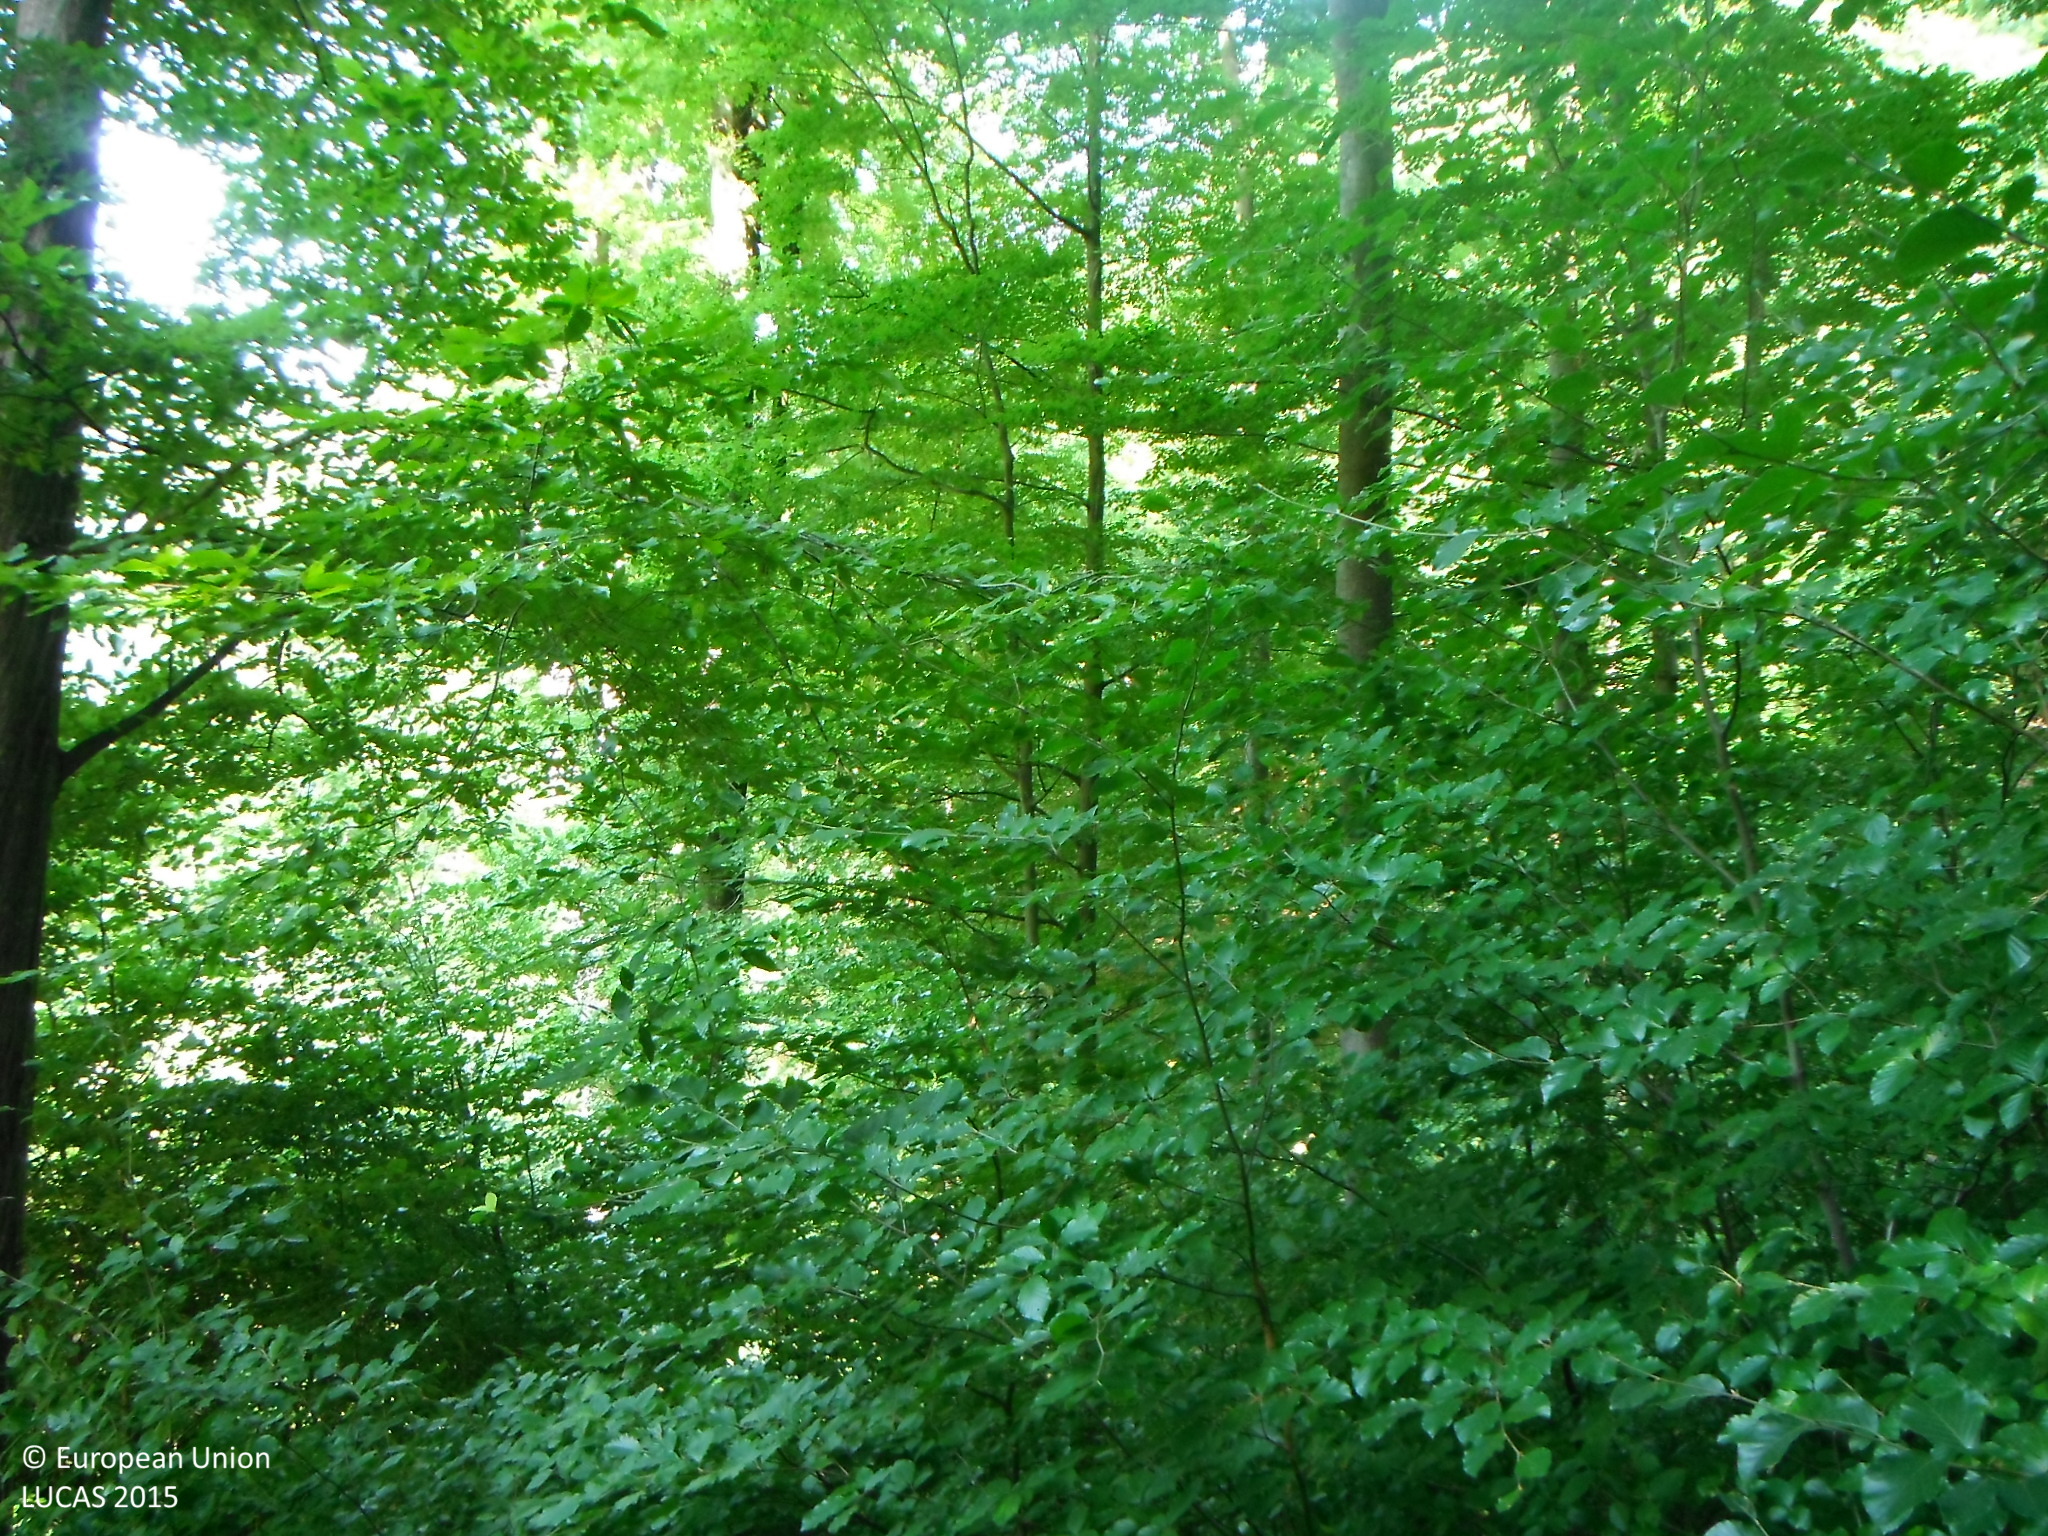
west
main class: Woodland
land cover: Broadleaved woodland
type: beech forest
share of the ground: > 75 %
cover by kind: broadleaved forest trees 90 %, herbaceous plants 10 %
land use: Forestry
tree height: > 5 m
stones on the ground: 25 - 50 %
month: July
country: SK
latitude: 48.5271
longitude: 19.1894
